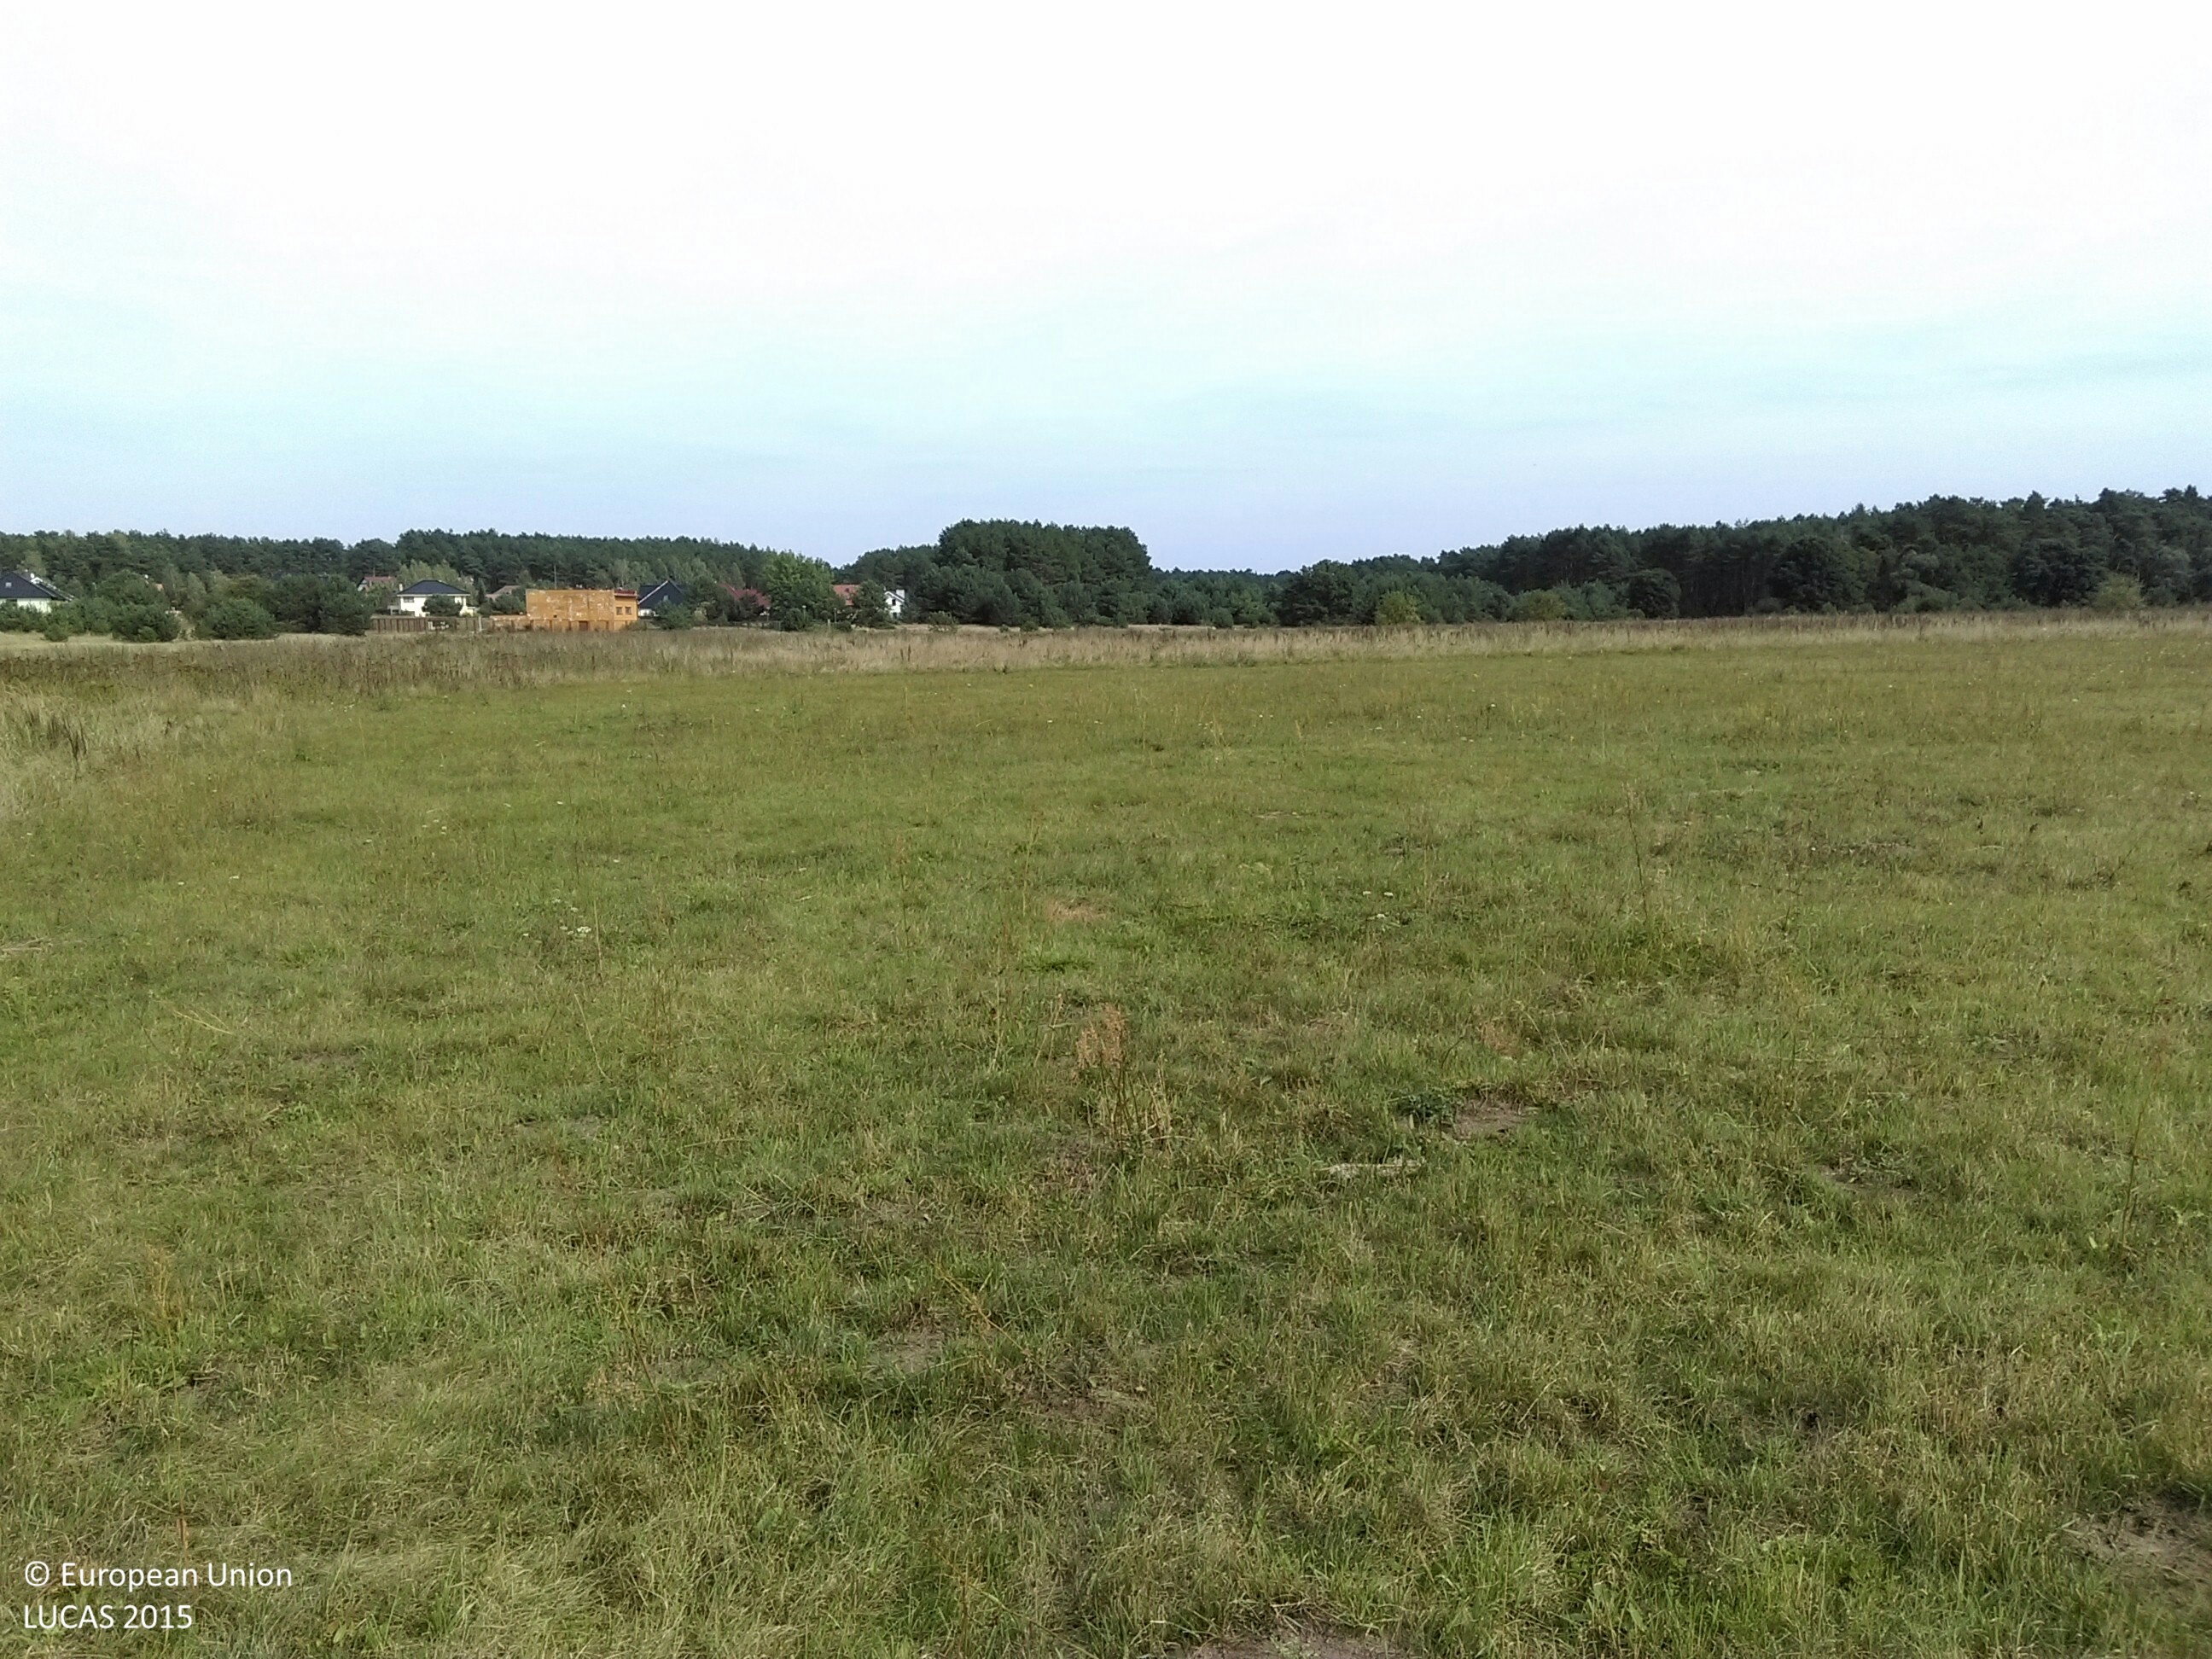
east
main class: Grassland
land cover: Grassland without tree/shrub cover
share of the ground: > 75 %
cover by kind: herbaceous plants 100 %
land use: Agriculture (excluding fallow land and kitchen gardens)
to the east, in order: Grassland without tree/shrub cover; Spontaneously vegetated surfaces; Grassland with sparse tree/shrub cover
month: September
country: PL
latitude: 51.8864
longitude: 15.5689
